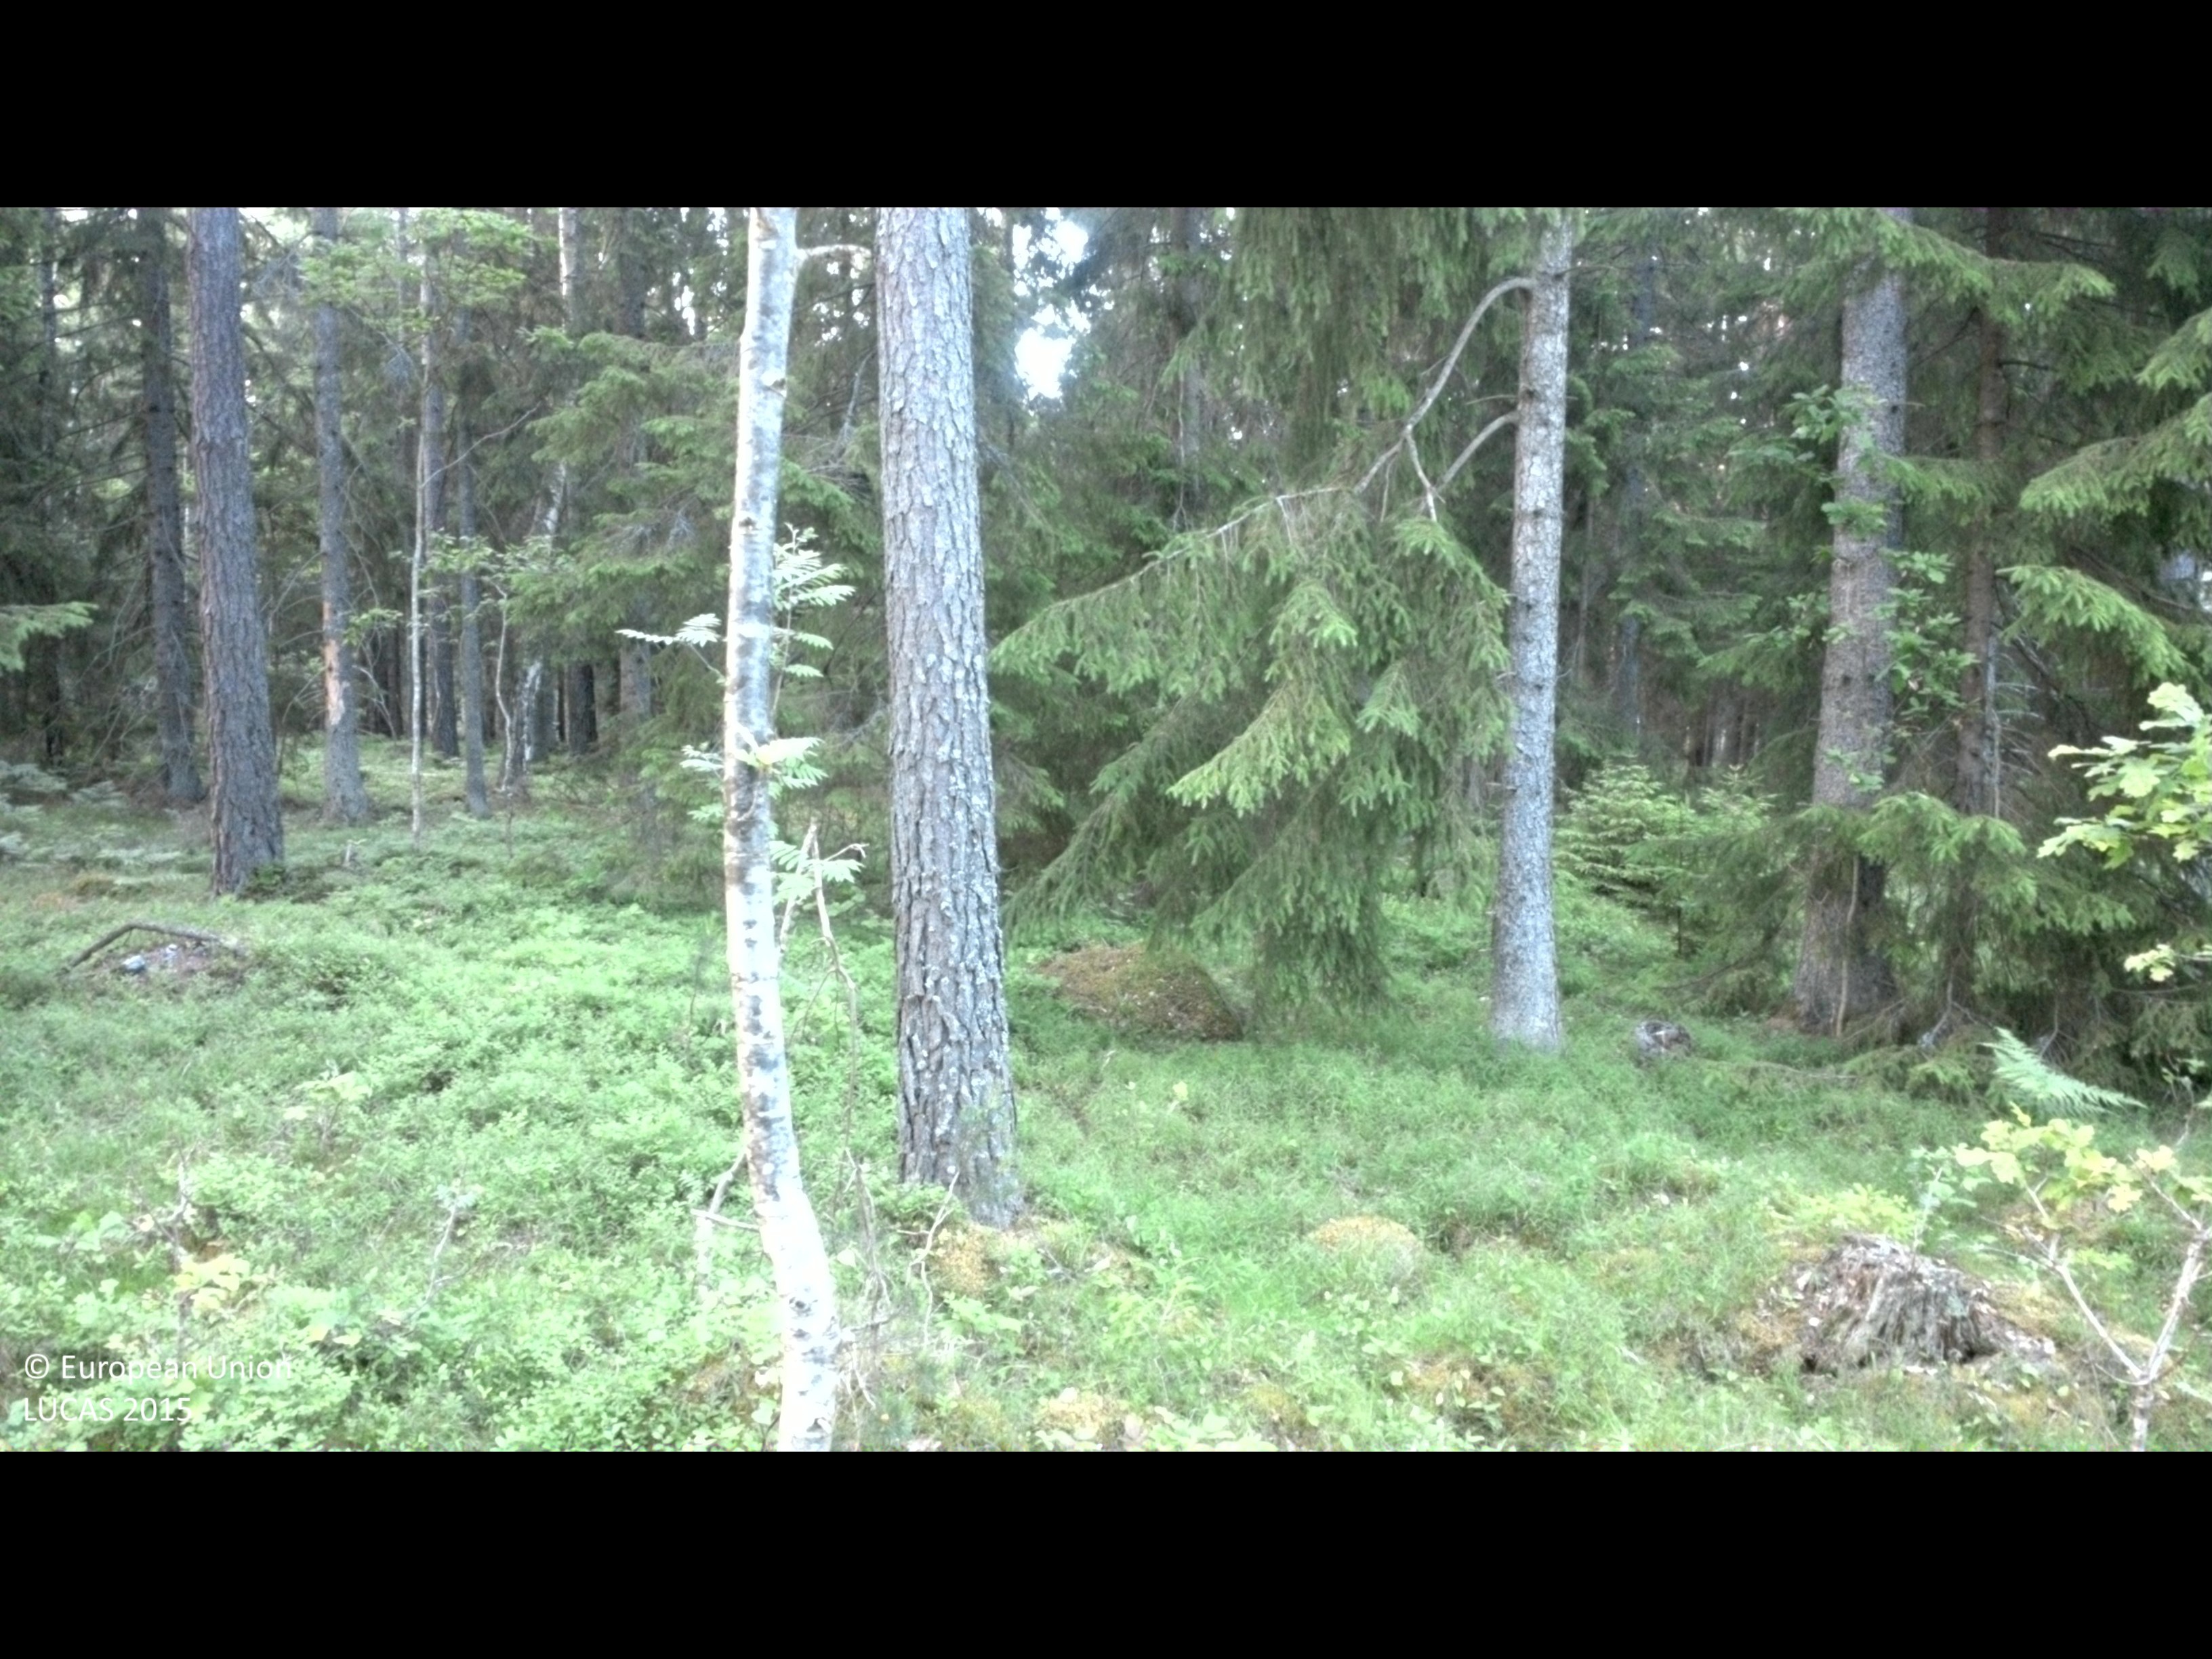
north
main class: Woodland
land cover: Pine dominated mixed woodland
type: hemiboreal forest and nemoral coniferous forest and mixed broadleaved-coniferous forest
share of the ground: > 75 %
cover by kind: coniferous forest trees 60 %, broadleaved forest trees 20 %, shrubs 15 %, herbaceous plants 5 %
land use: Forestry
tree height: > 5 m
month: June
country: SE
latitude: 57.8236
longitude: 16.5816
